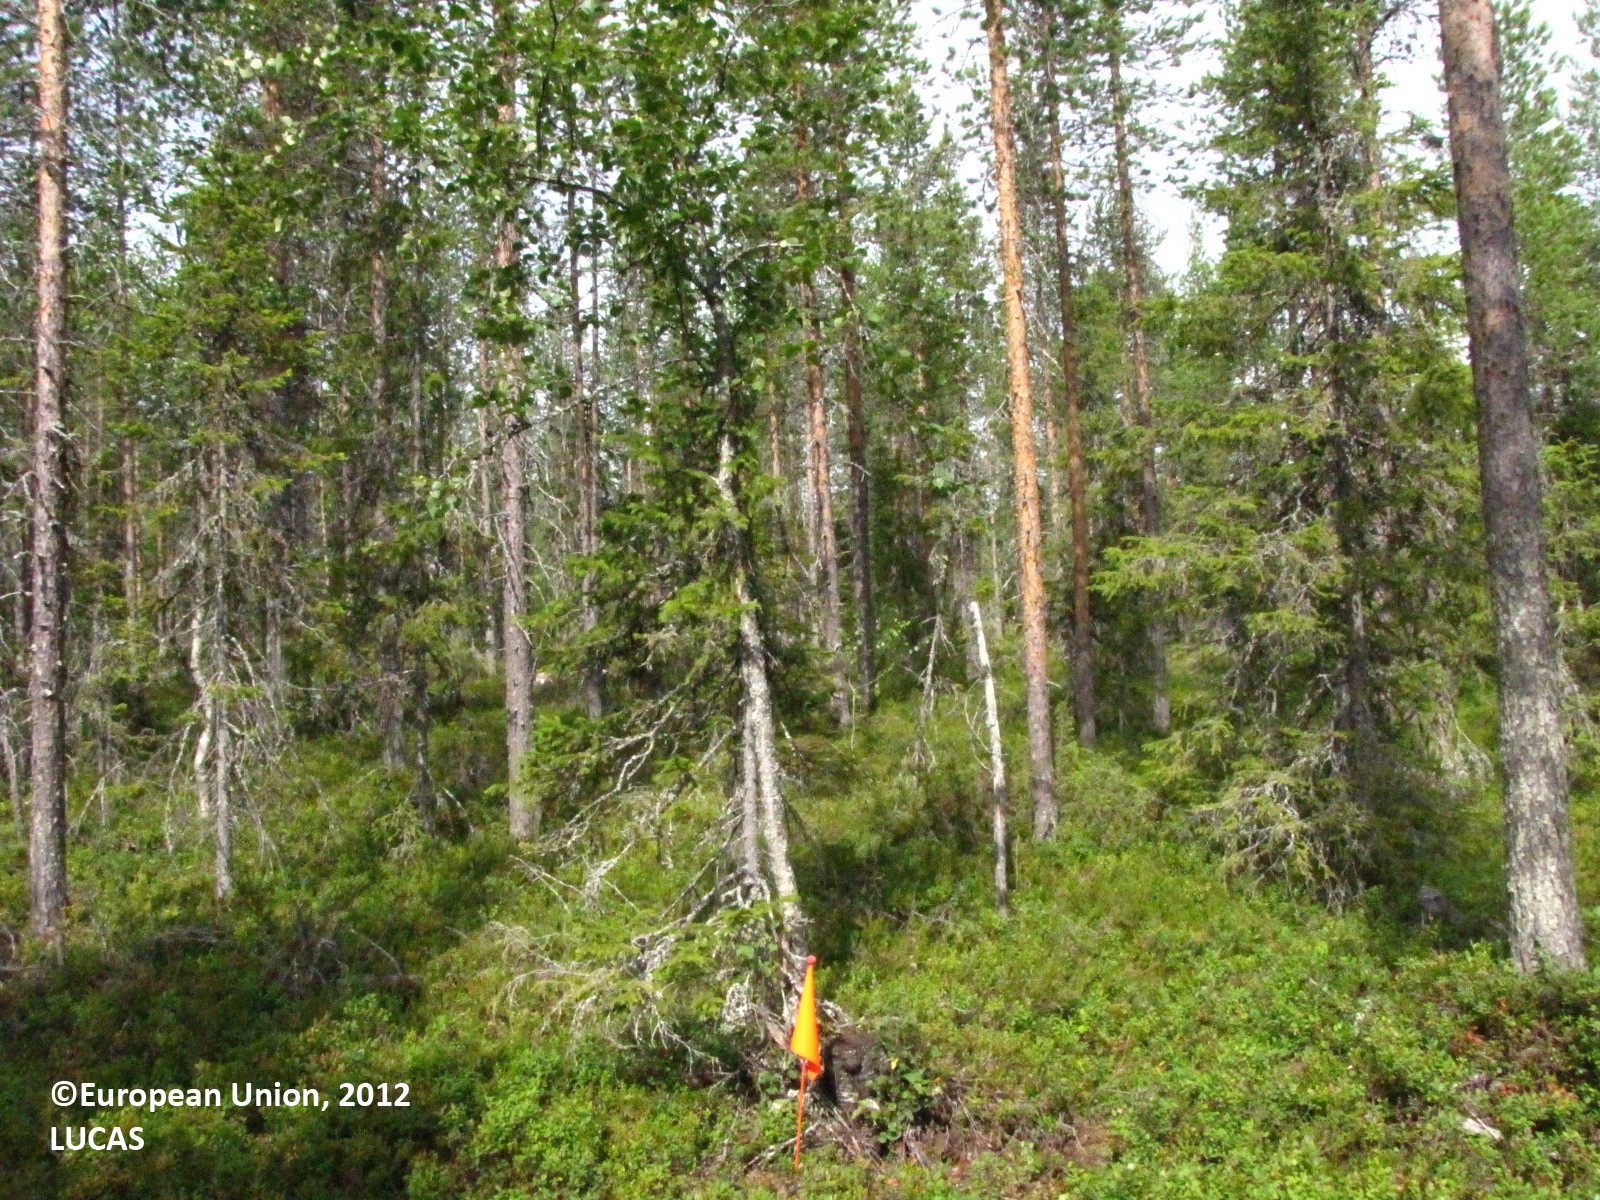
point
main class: Woodland
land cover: Other coniferous woodland
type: boreal forest
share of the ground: 50 - 75 %
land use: Forestry
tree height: > 5 m
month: July
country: FI
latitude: 66.7044
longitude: 25.0759
